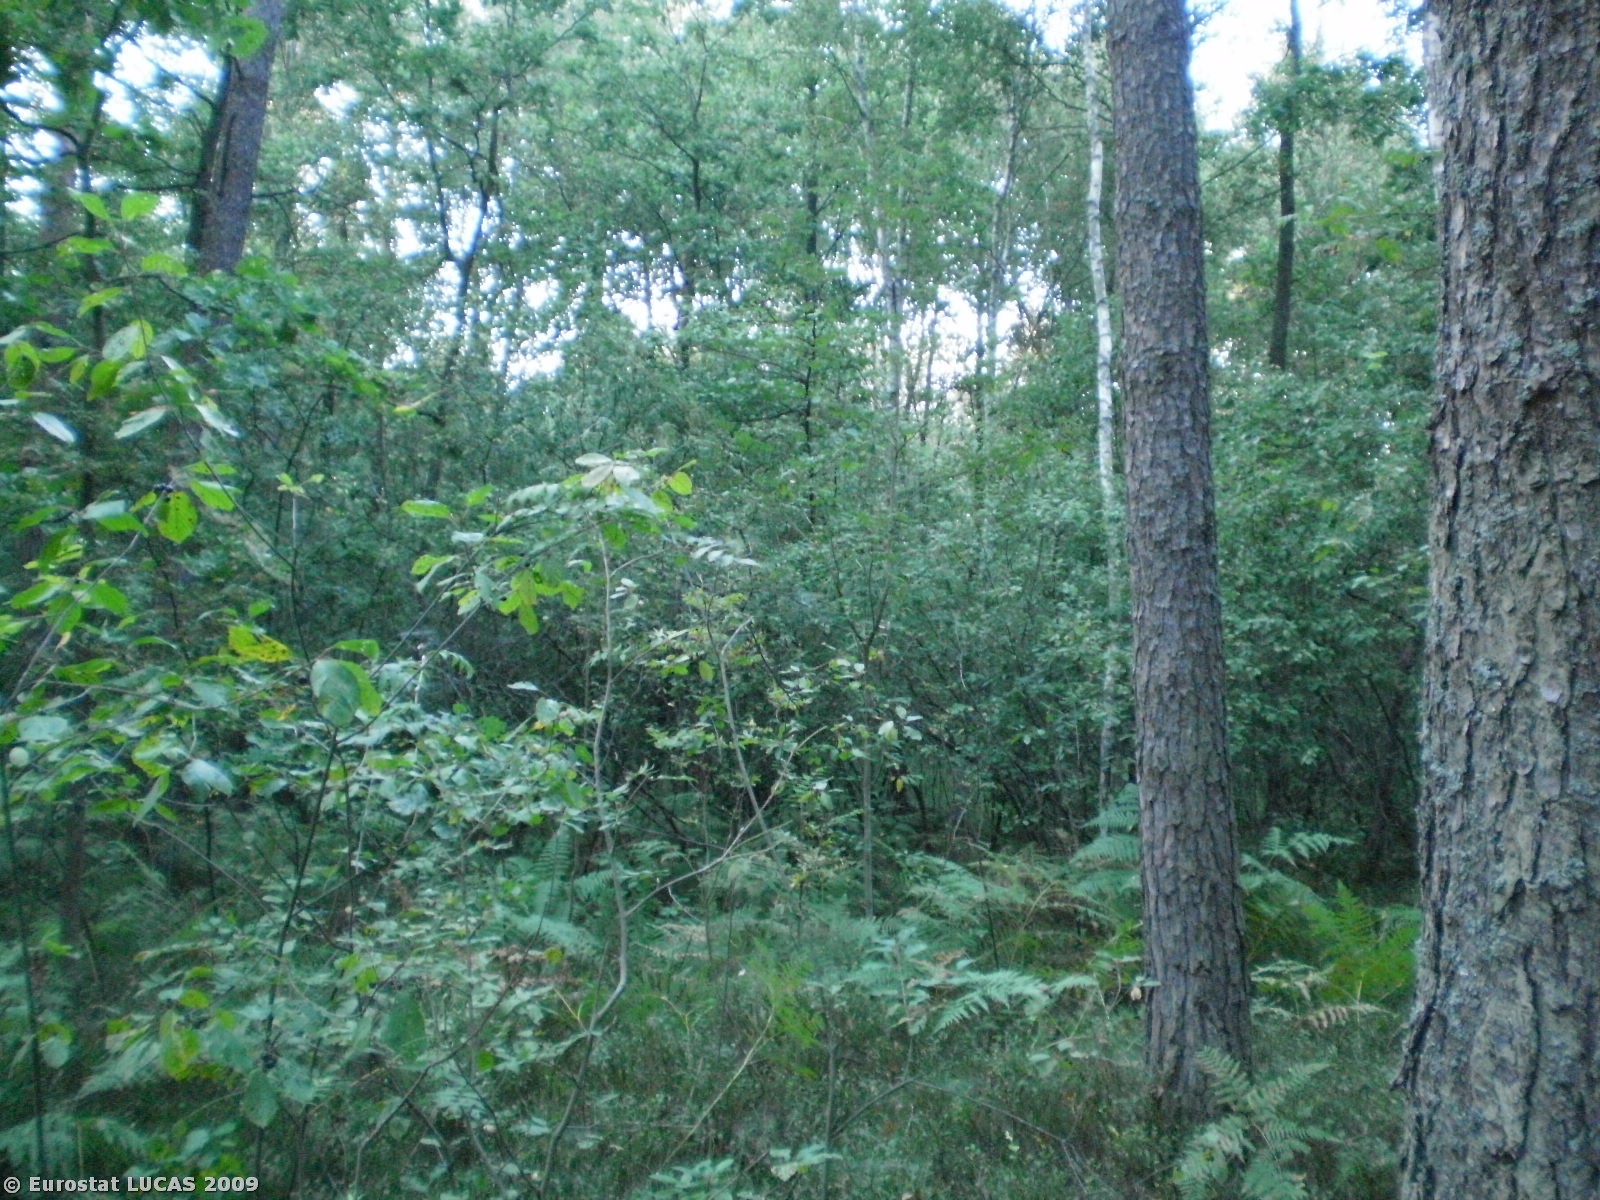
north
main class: Woodland
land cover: Mixed woodland
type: hemiboreal forest and nemoral coniferous forest and mixed broadleaved-coniferous forest
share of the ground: > 75 %
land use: Forestry
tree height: > 5 m
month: August
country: PL
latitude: 52.5931
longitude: 21.7310
